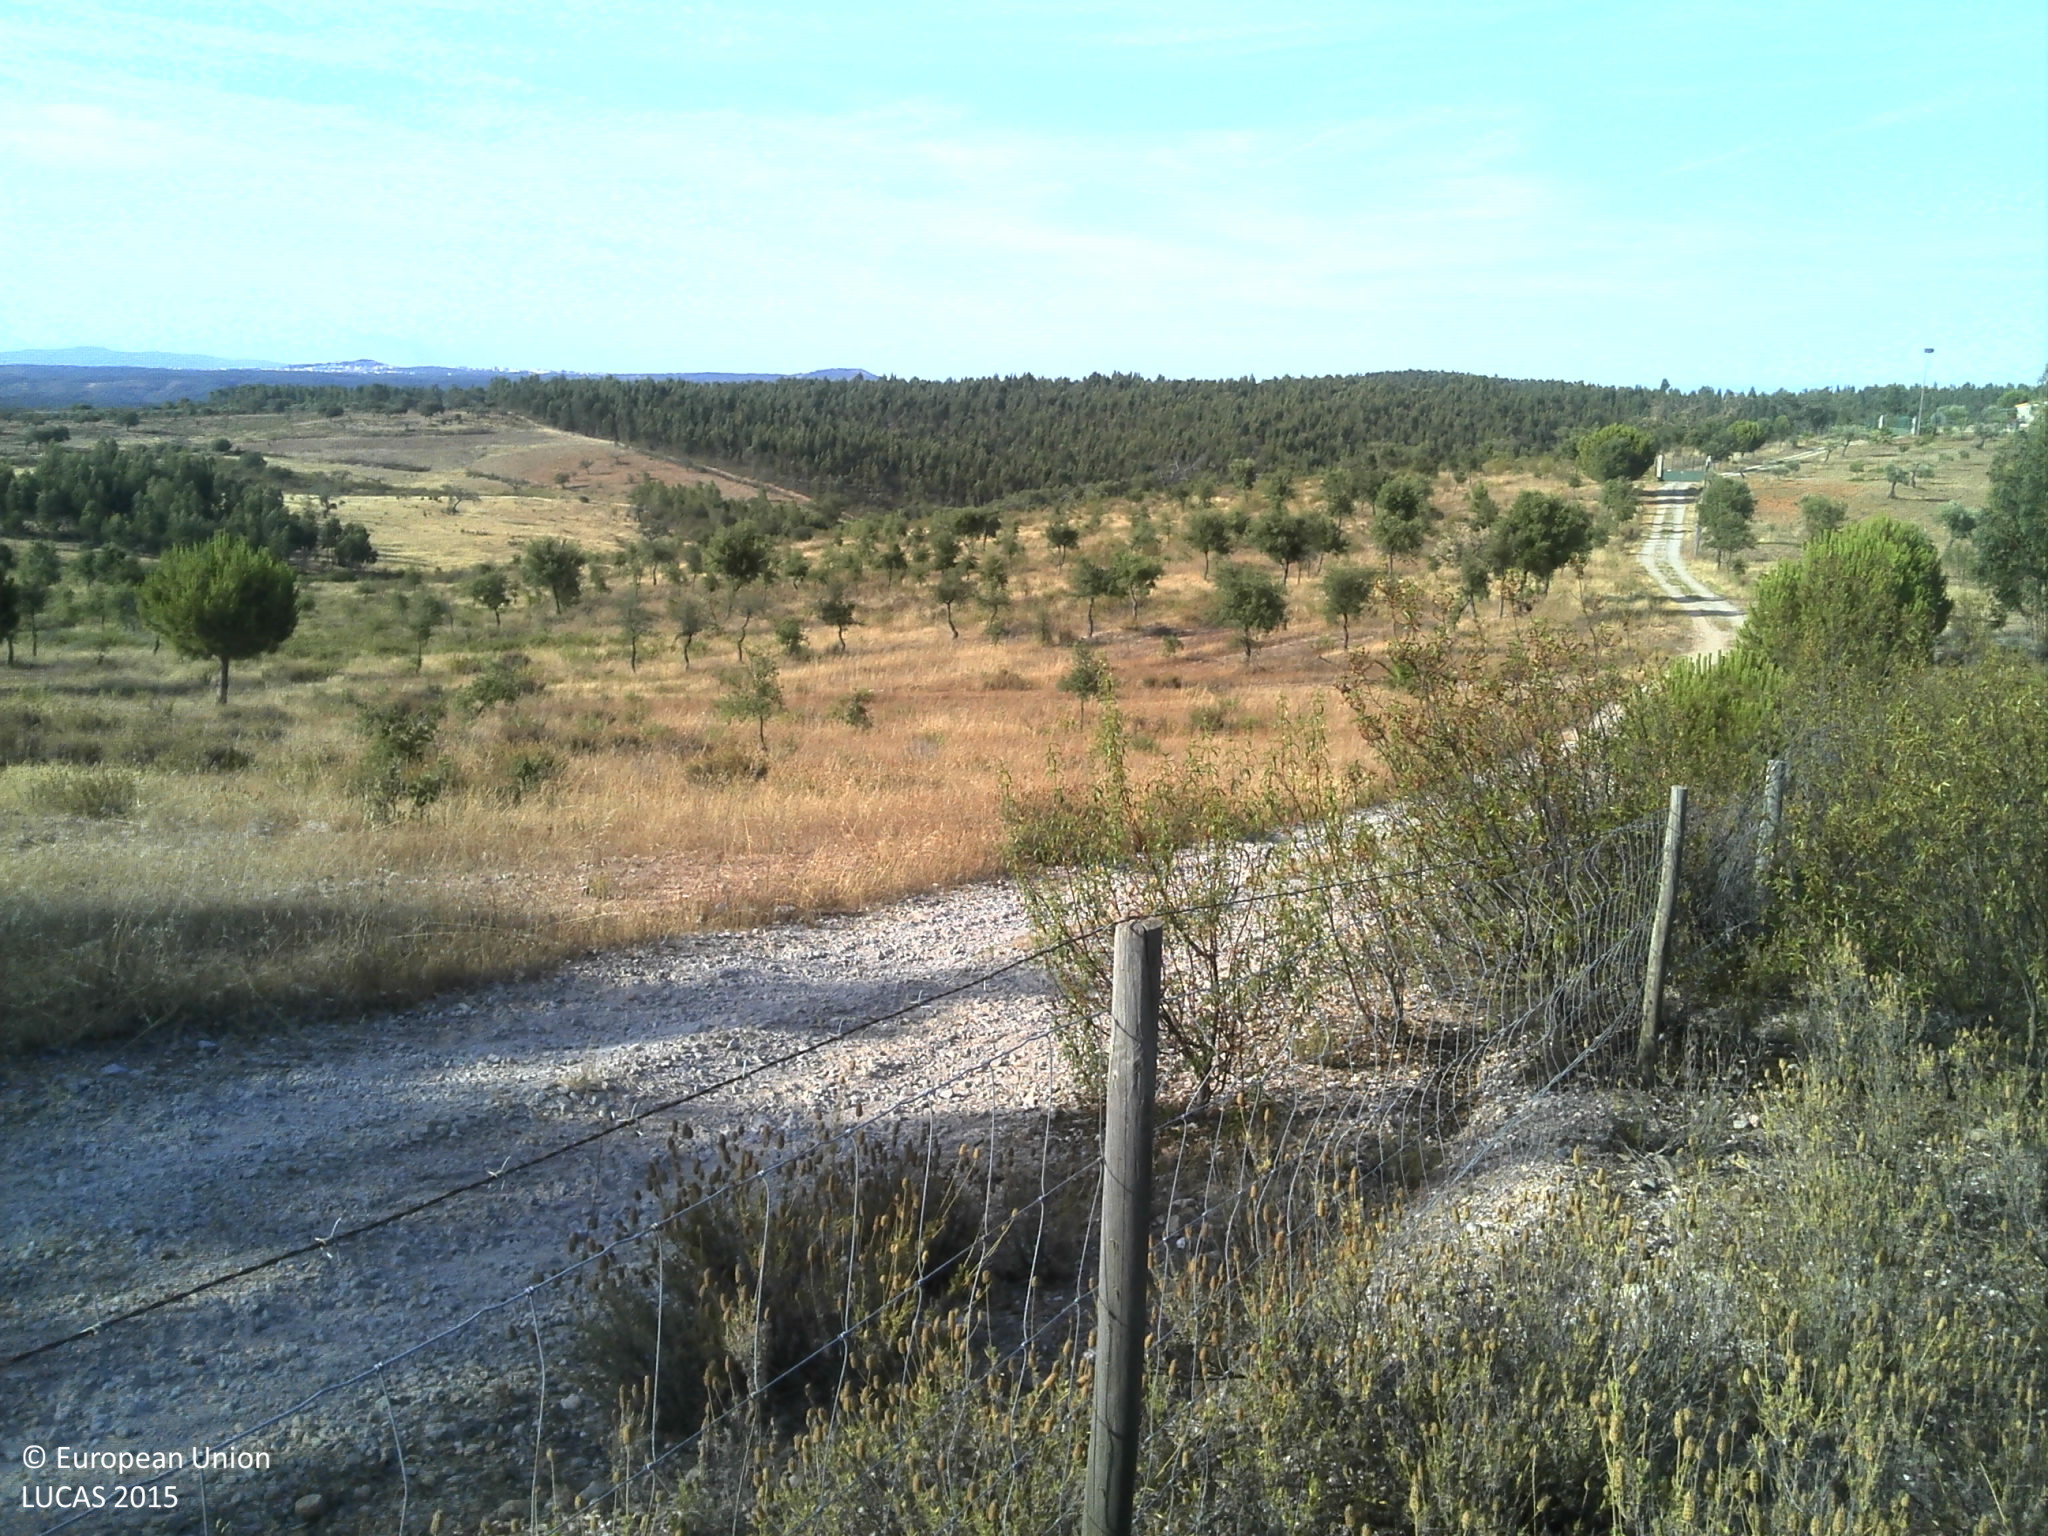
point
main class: Woodland
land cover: Broadleaved woodland
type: broadleaved evergreen forest
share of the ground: 10 - 25 %
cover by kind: unconsolidated bare surface 60 %, broadleaved forest trees 20 %, shrubs 10 %, herbaceous plants 10 %
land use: Forestry
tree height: < 5 m
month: July
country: PT
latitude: 39.6945
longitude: -7.5077
